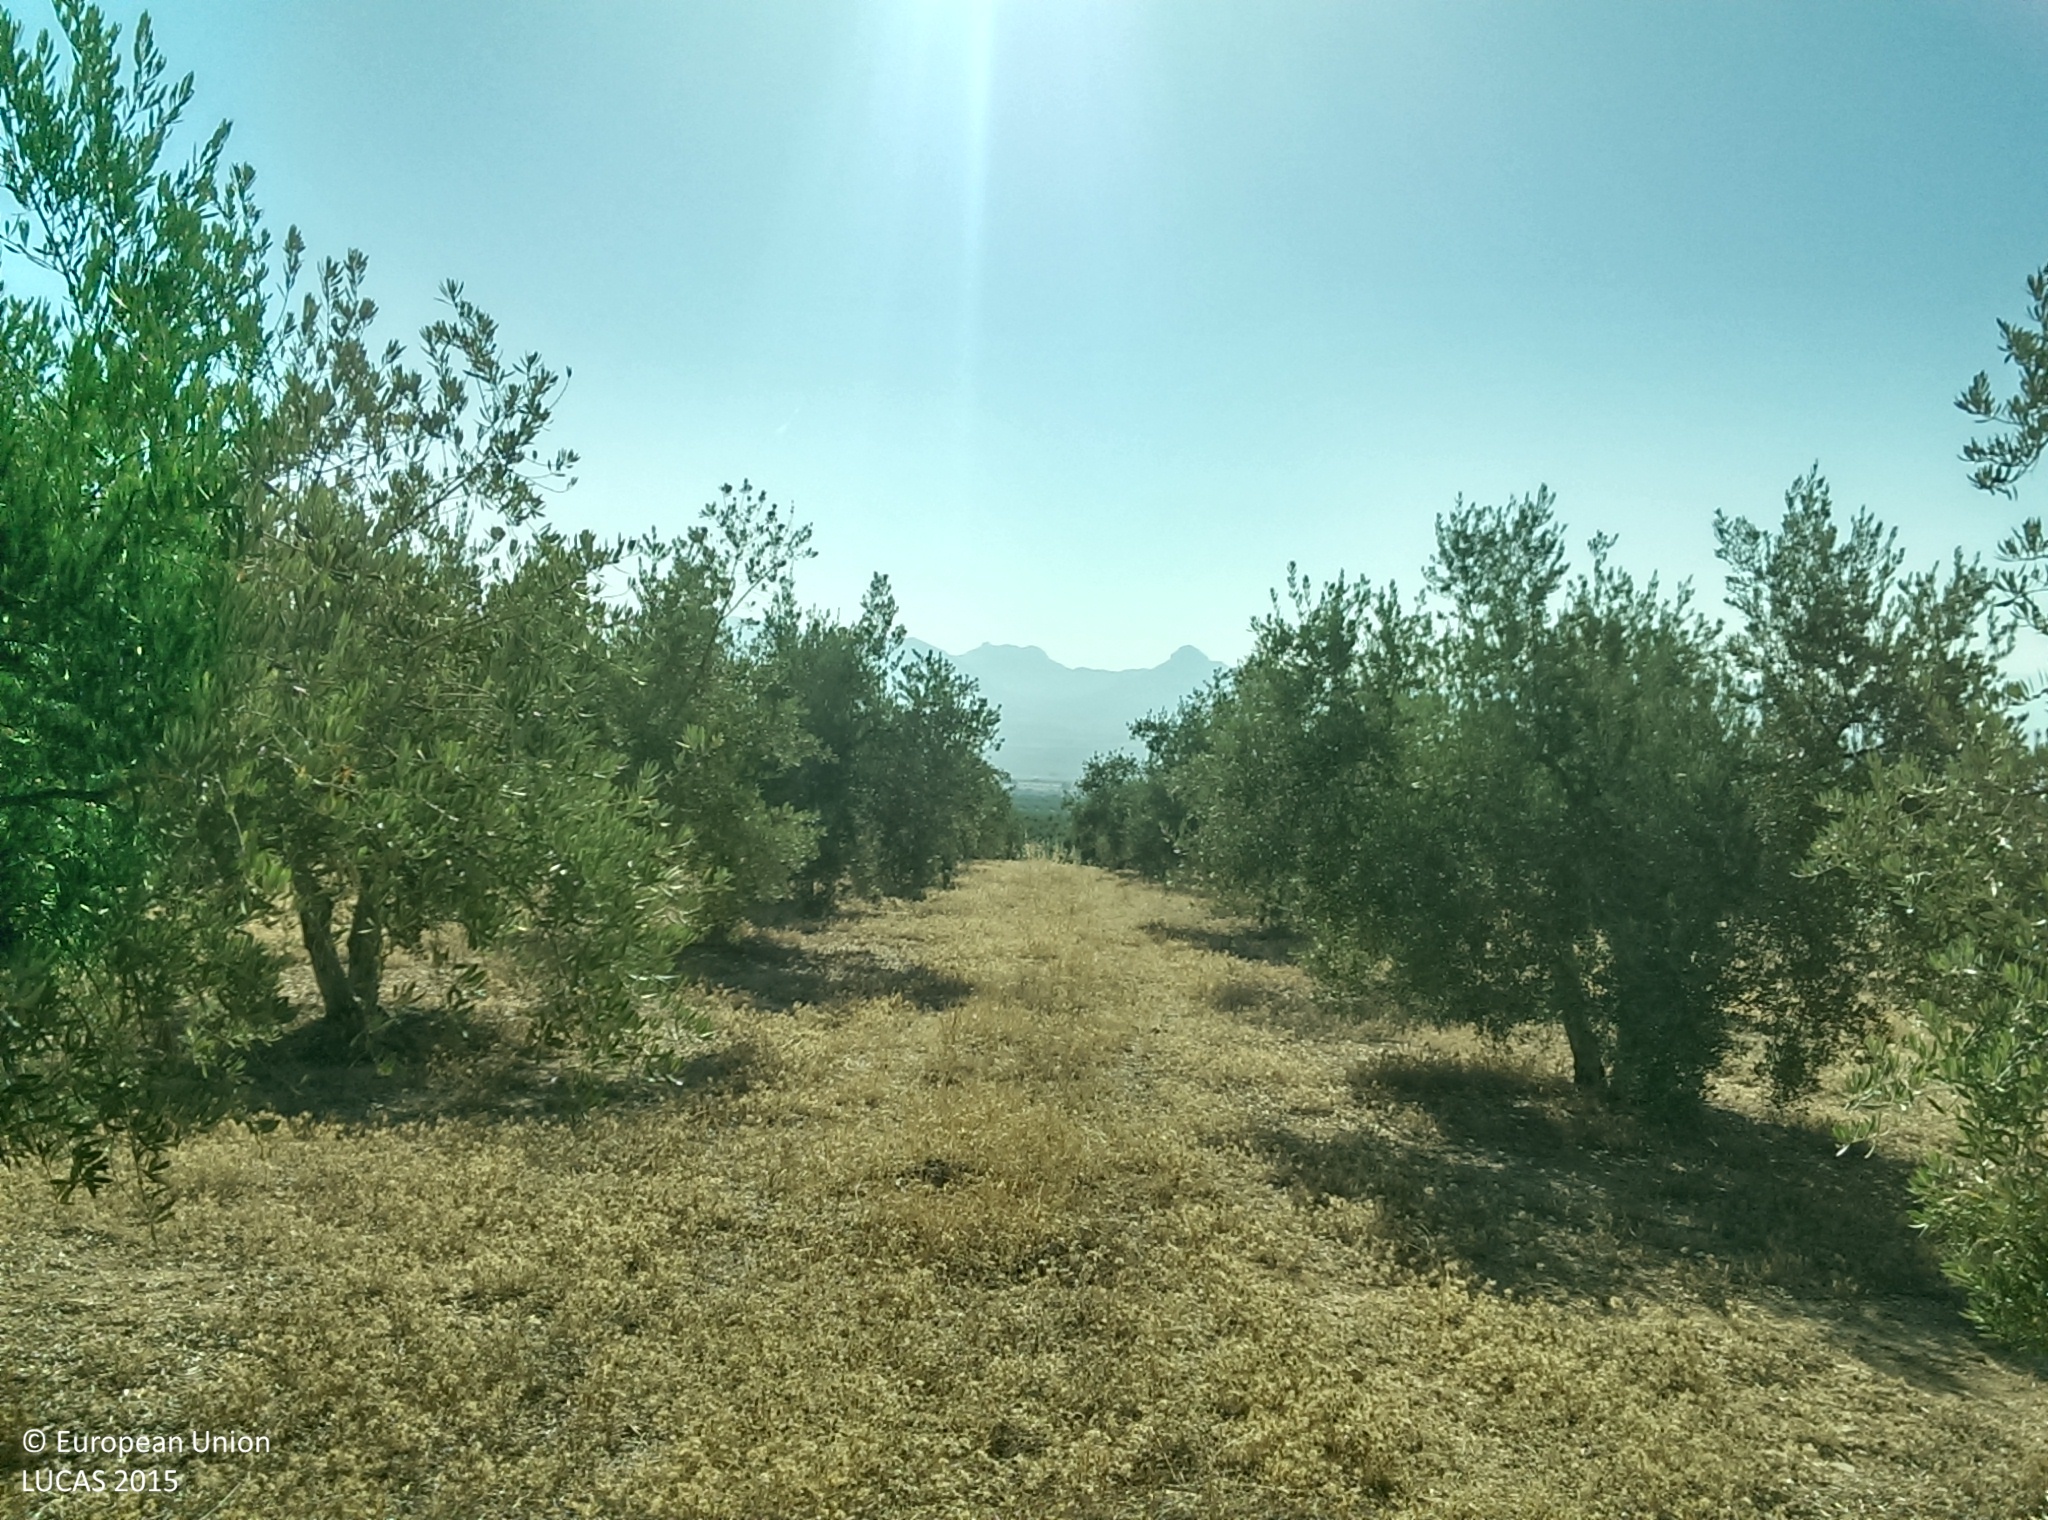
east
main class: Cropland
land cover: Olive groves
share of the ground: 25 - 50 %
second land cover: Spontaneously vegetated surfaces
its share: 25 - 50 %
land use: Agriculture (excluding fallow land and kitchen gardens)
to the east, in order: Olive groves; Spontaneously vegetated surfaces; Tracks; Olive groves
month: July
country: ES
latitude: 37.2987
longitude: -3.7217
